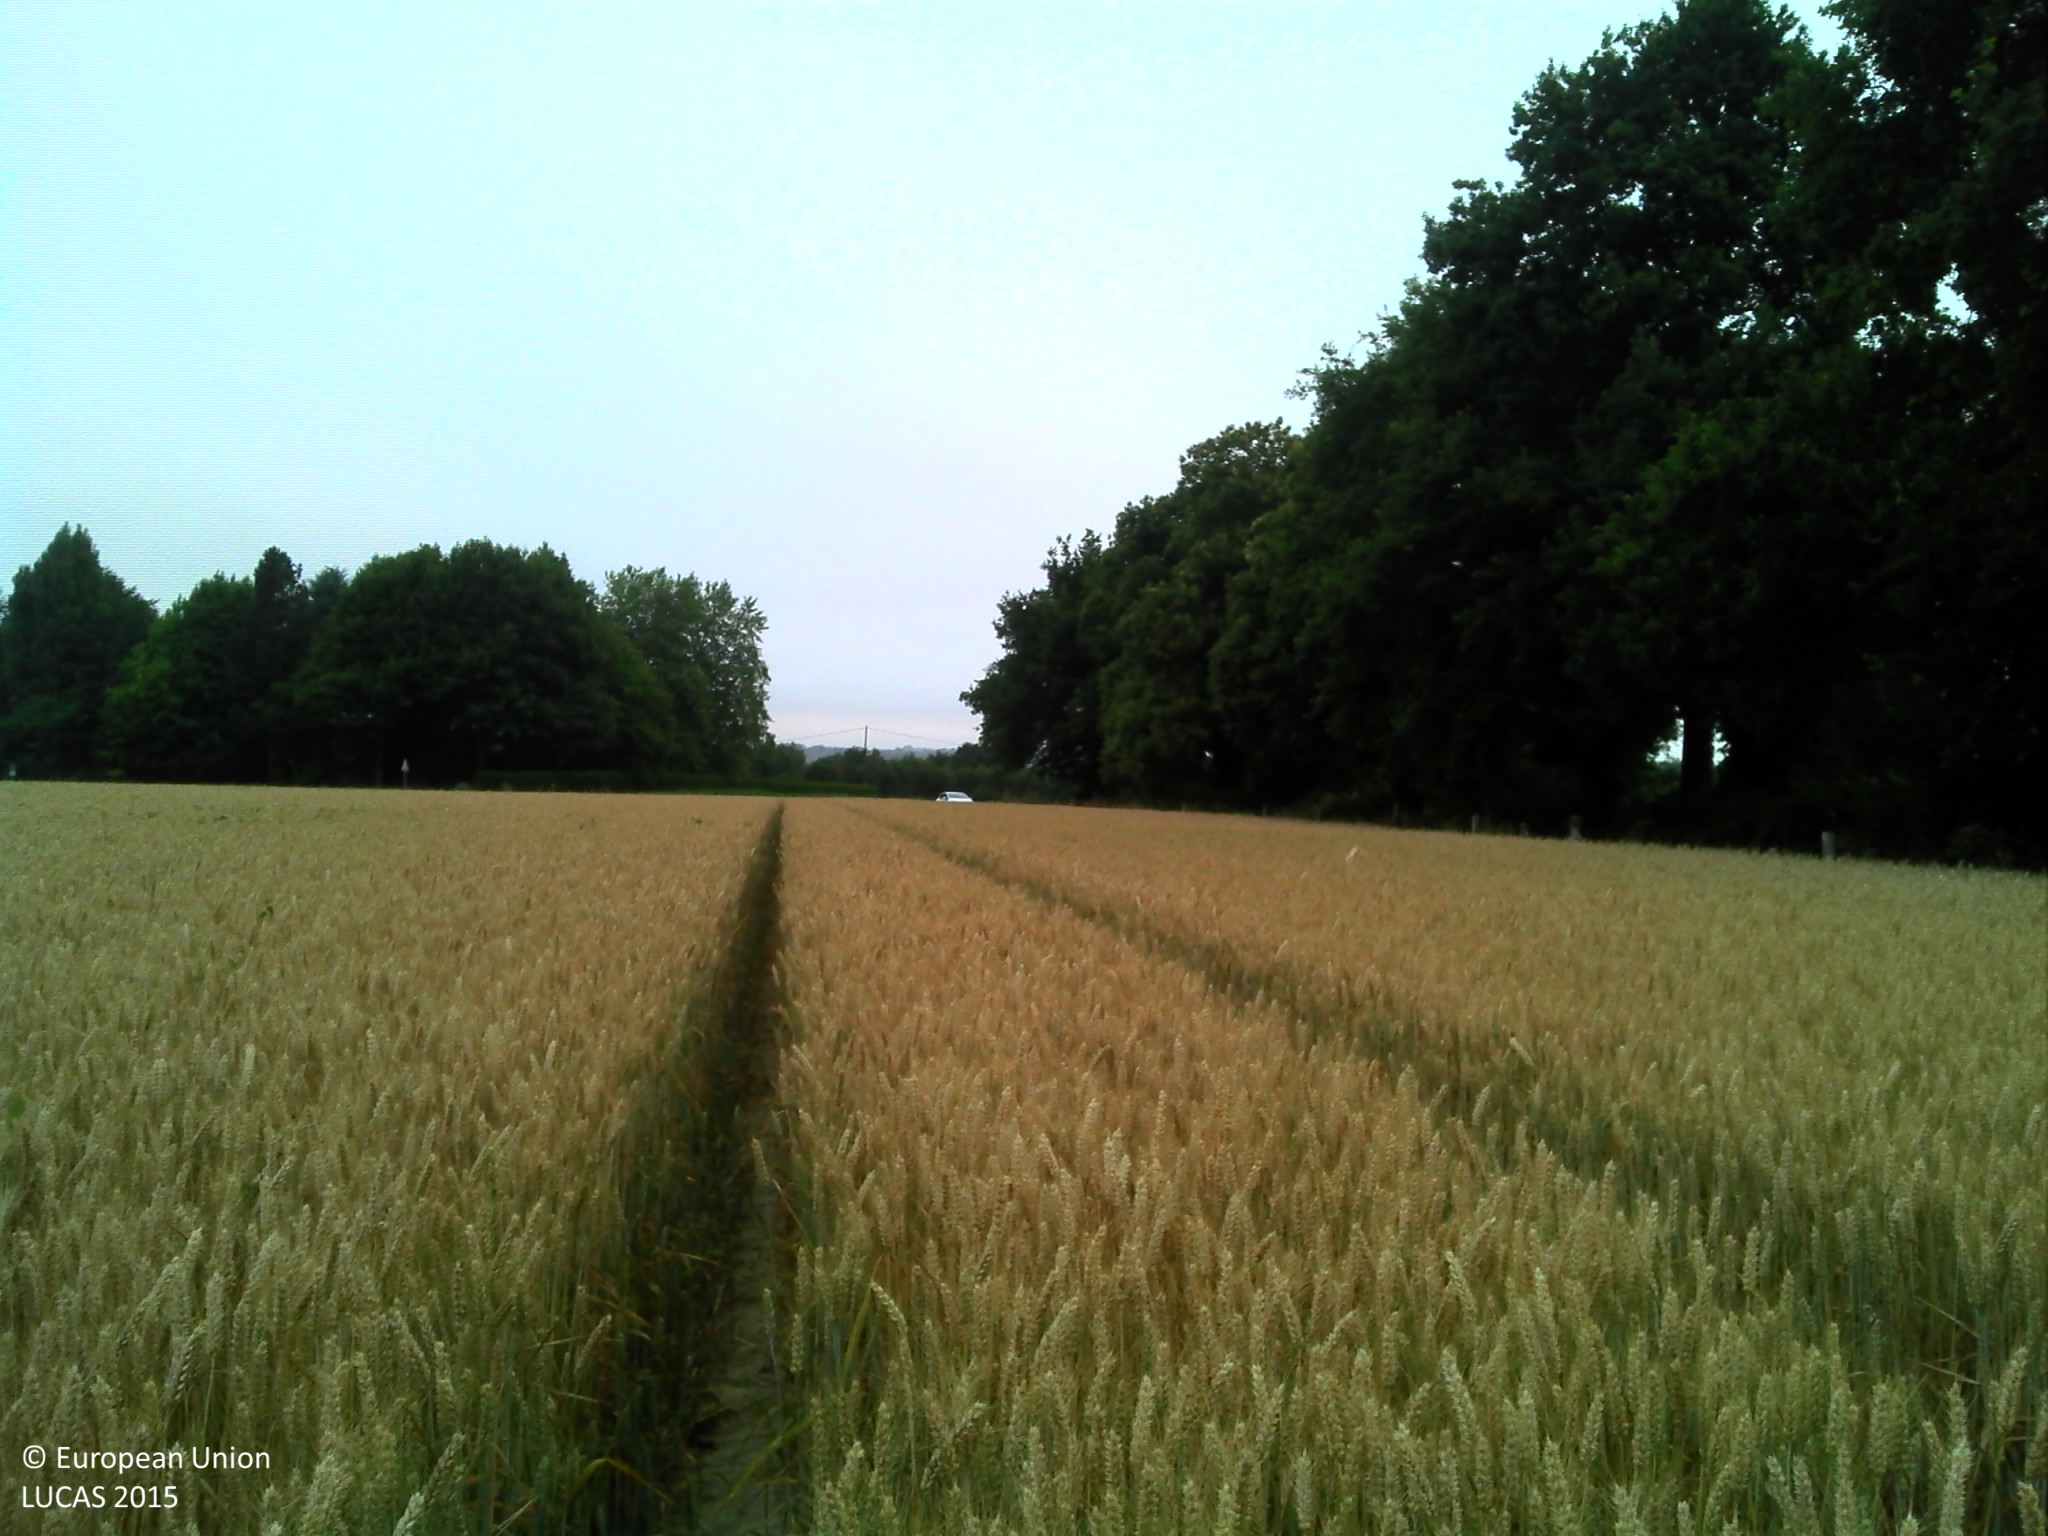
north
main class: Cropland
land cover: Common wheat
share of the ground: > 75 %
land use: Agriculture (excluding fallow land and kitchen gardens)
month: July
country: FR
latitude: 48.1966
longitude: -1.7132
